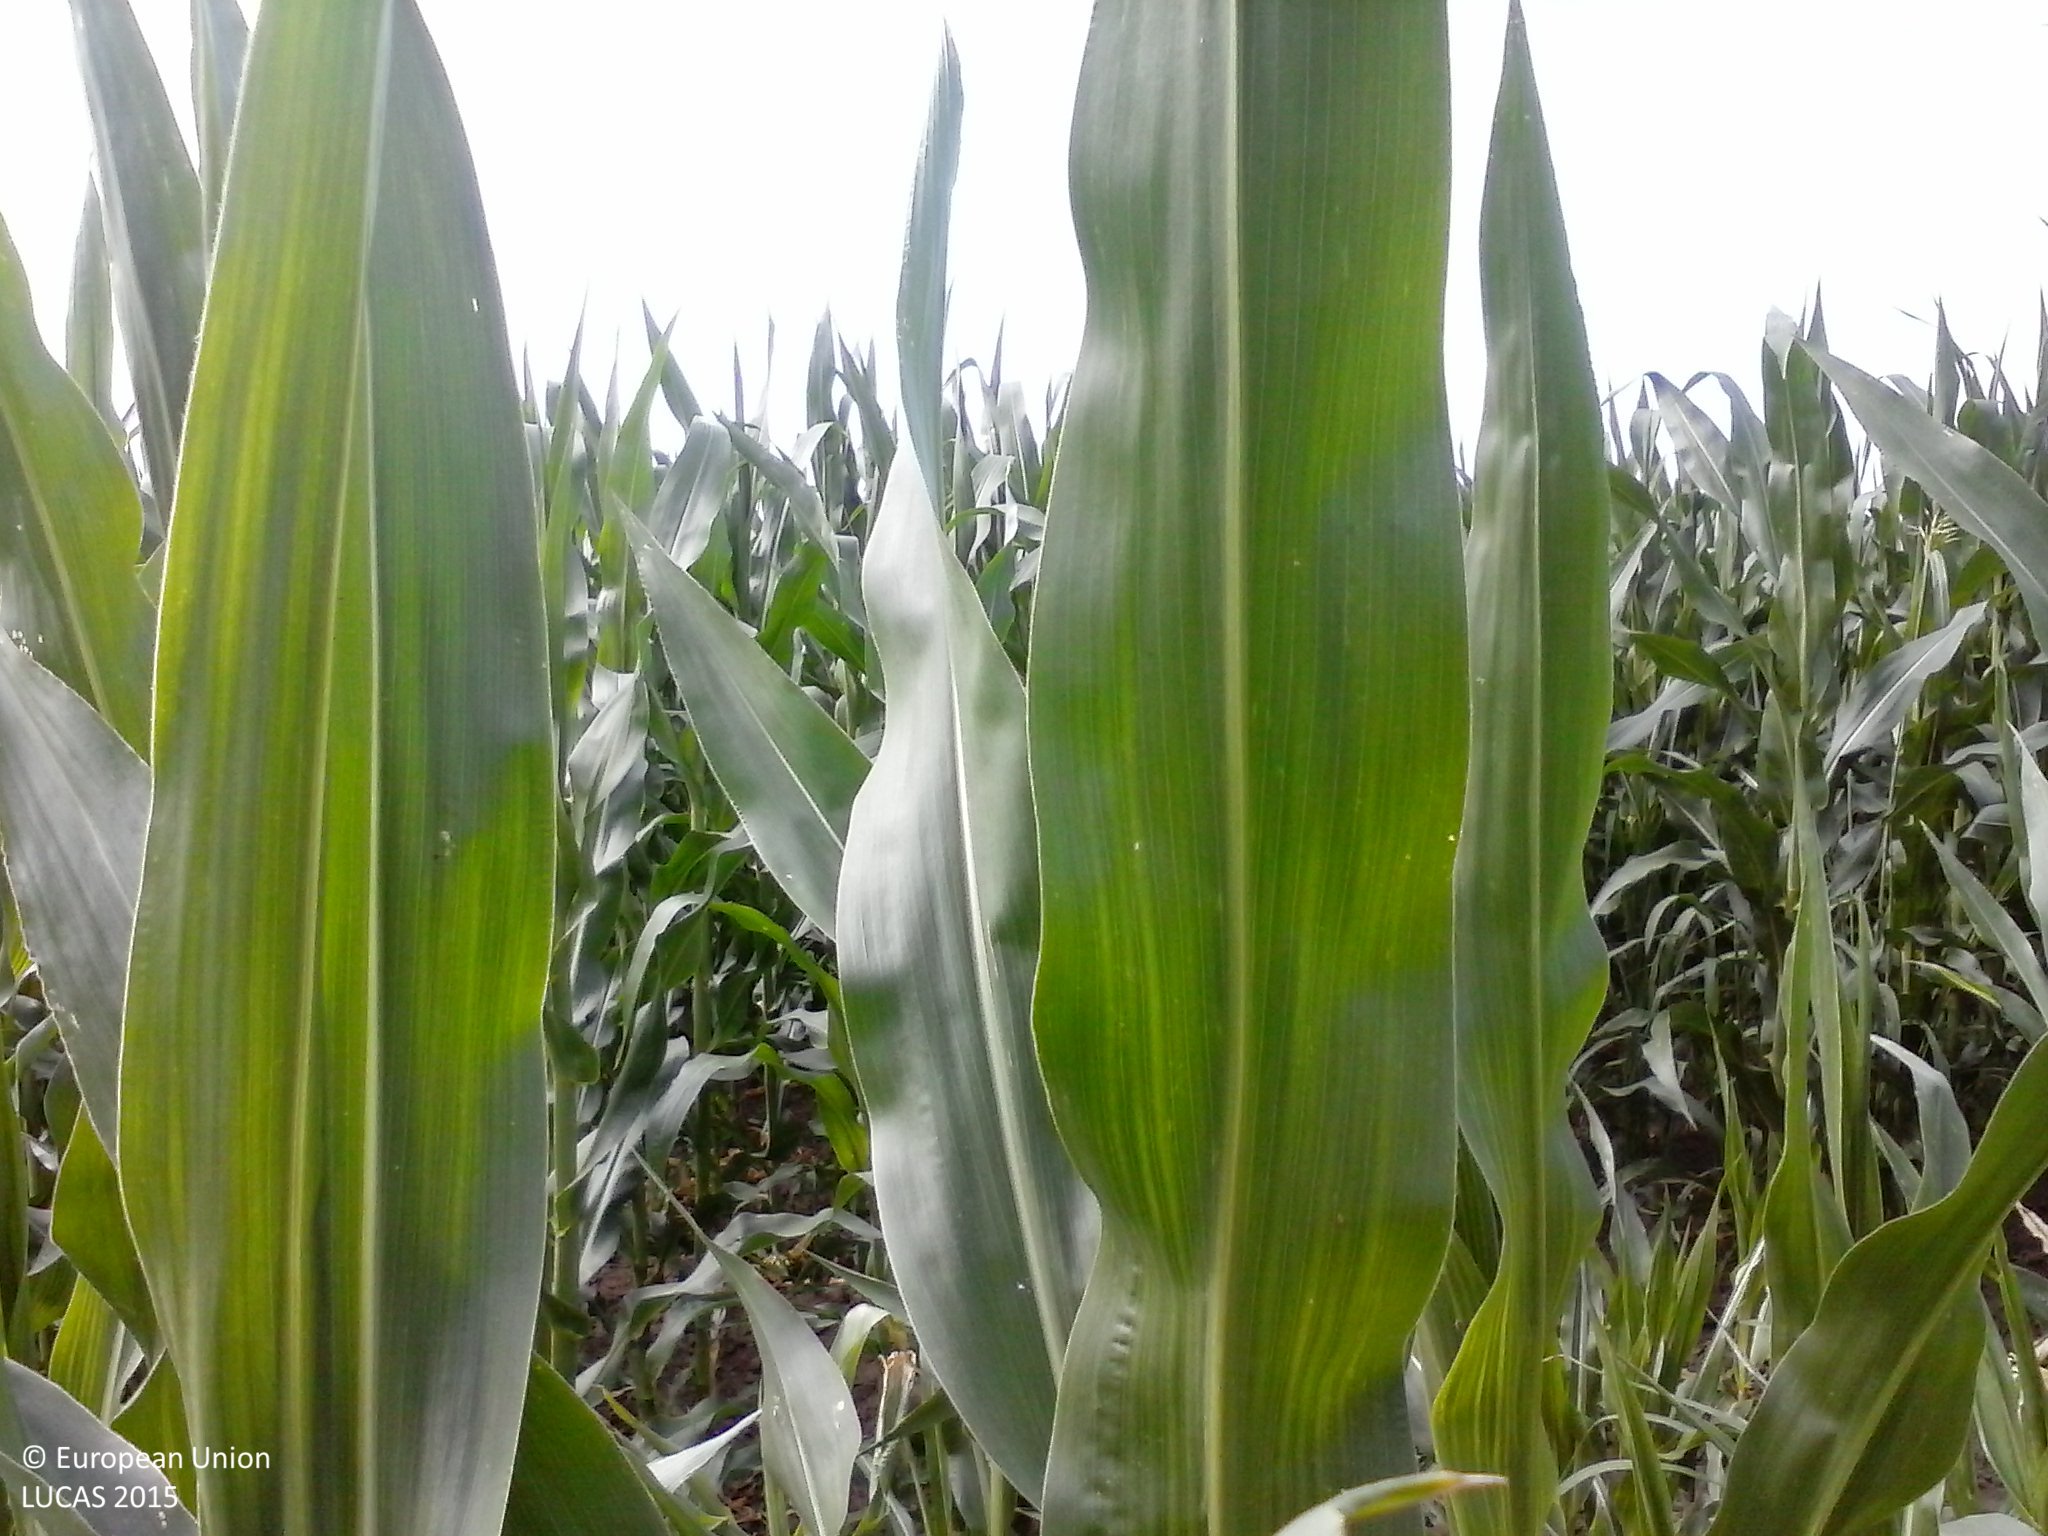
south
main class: Cropland
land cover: Maize
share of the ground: > 75 %
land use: Agriculture (excluding fallow land and kitchen gardens)
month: June
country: HU
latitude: 46.1981
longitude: 19.5150
